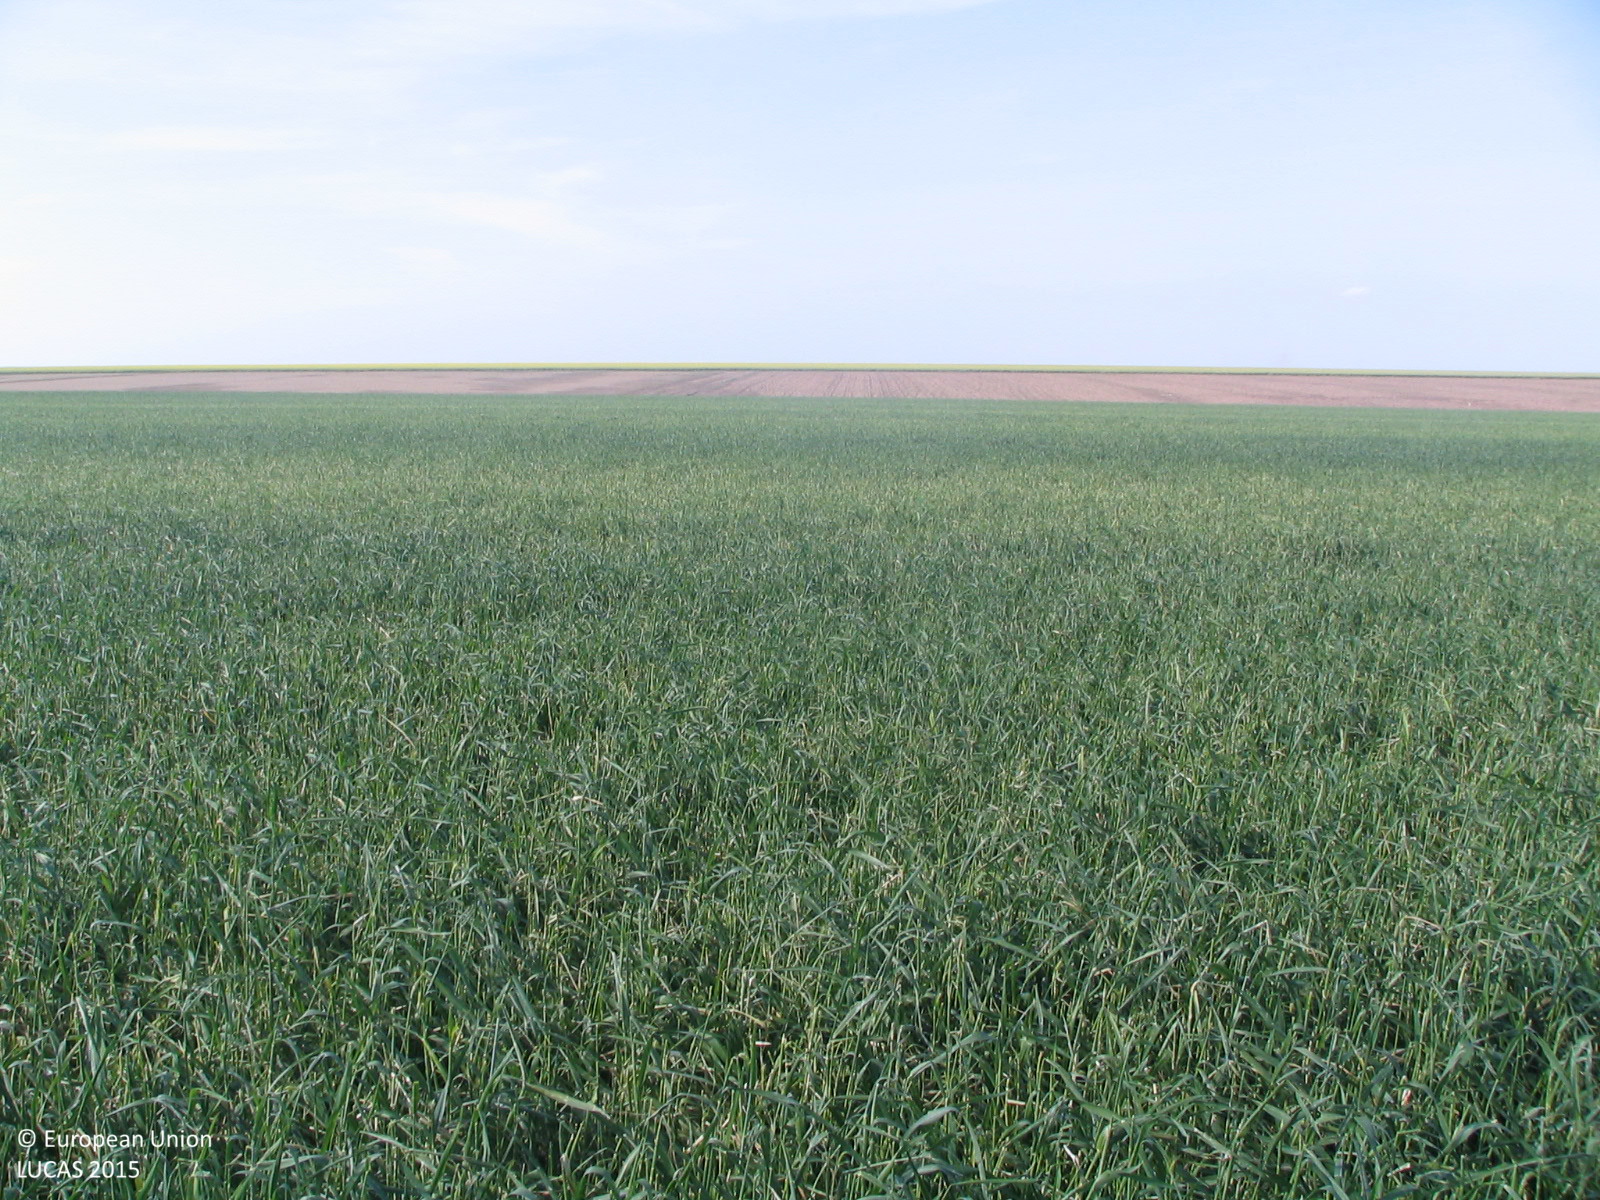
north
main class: Cropland
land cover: Common wheat
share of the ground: > 75 %
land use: Agriculture (excluding fallow land and kitchen gardens)
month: May
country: BG
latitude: 43.5632
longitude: 23.9810
